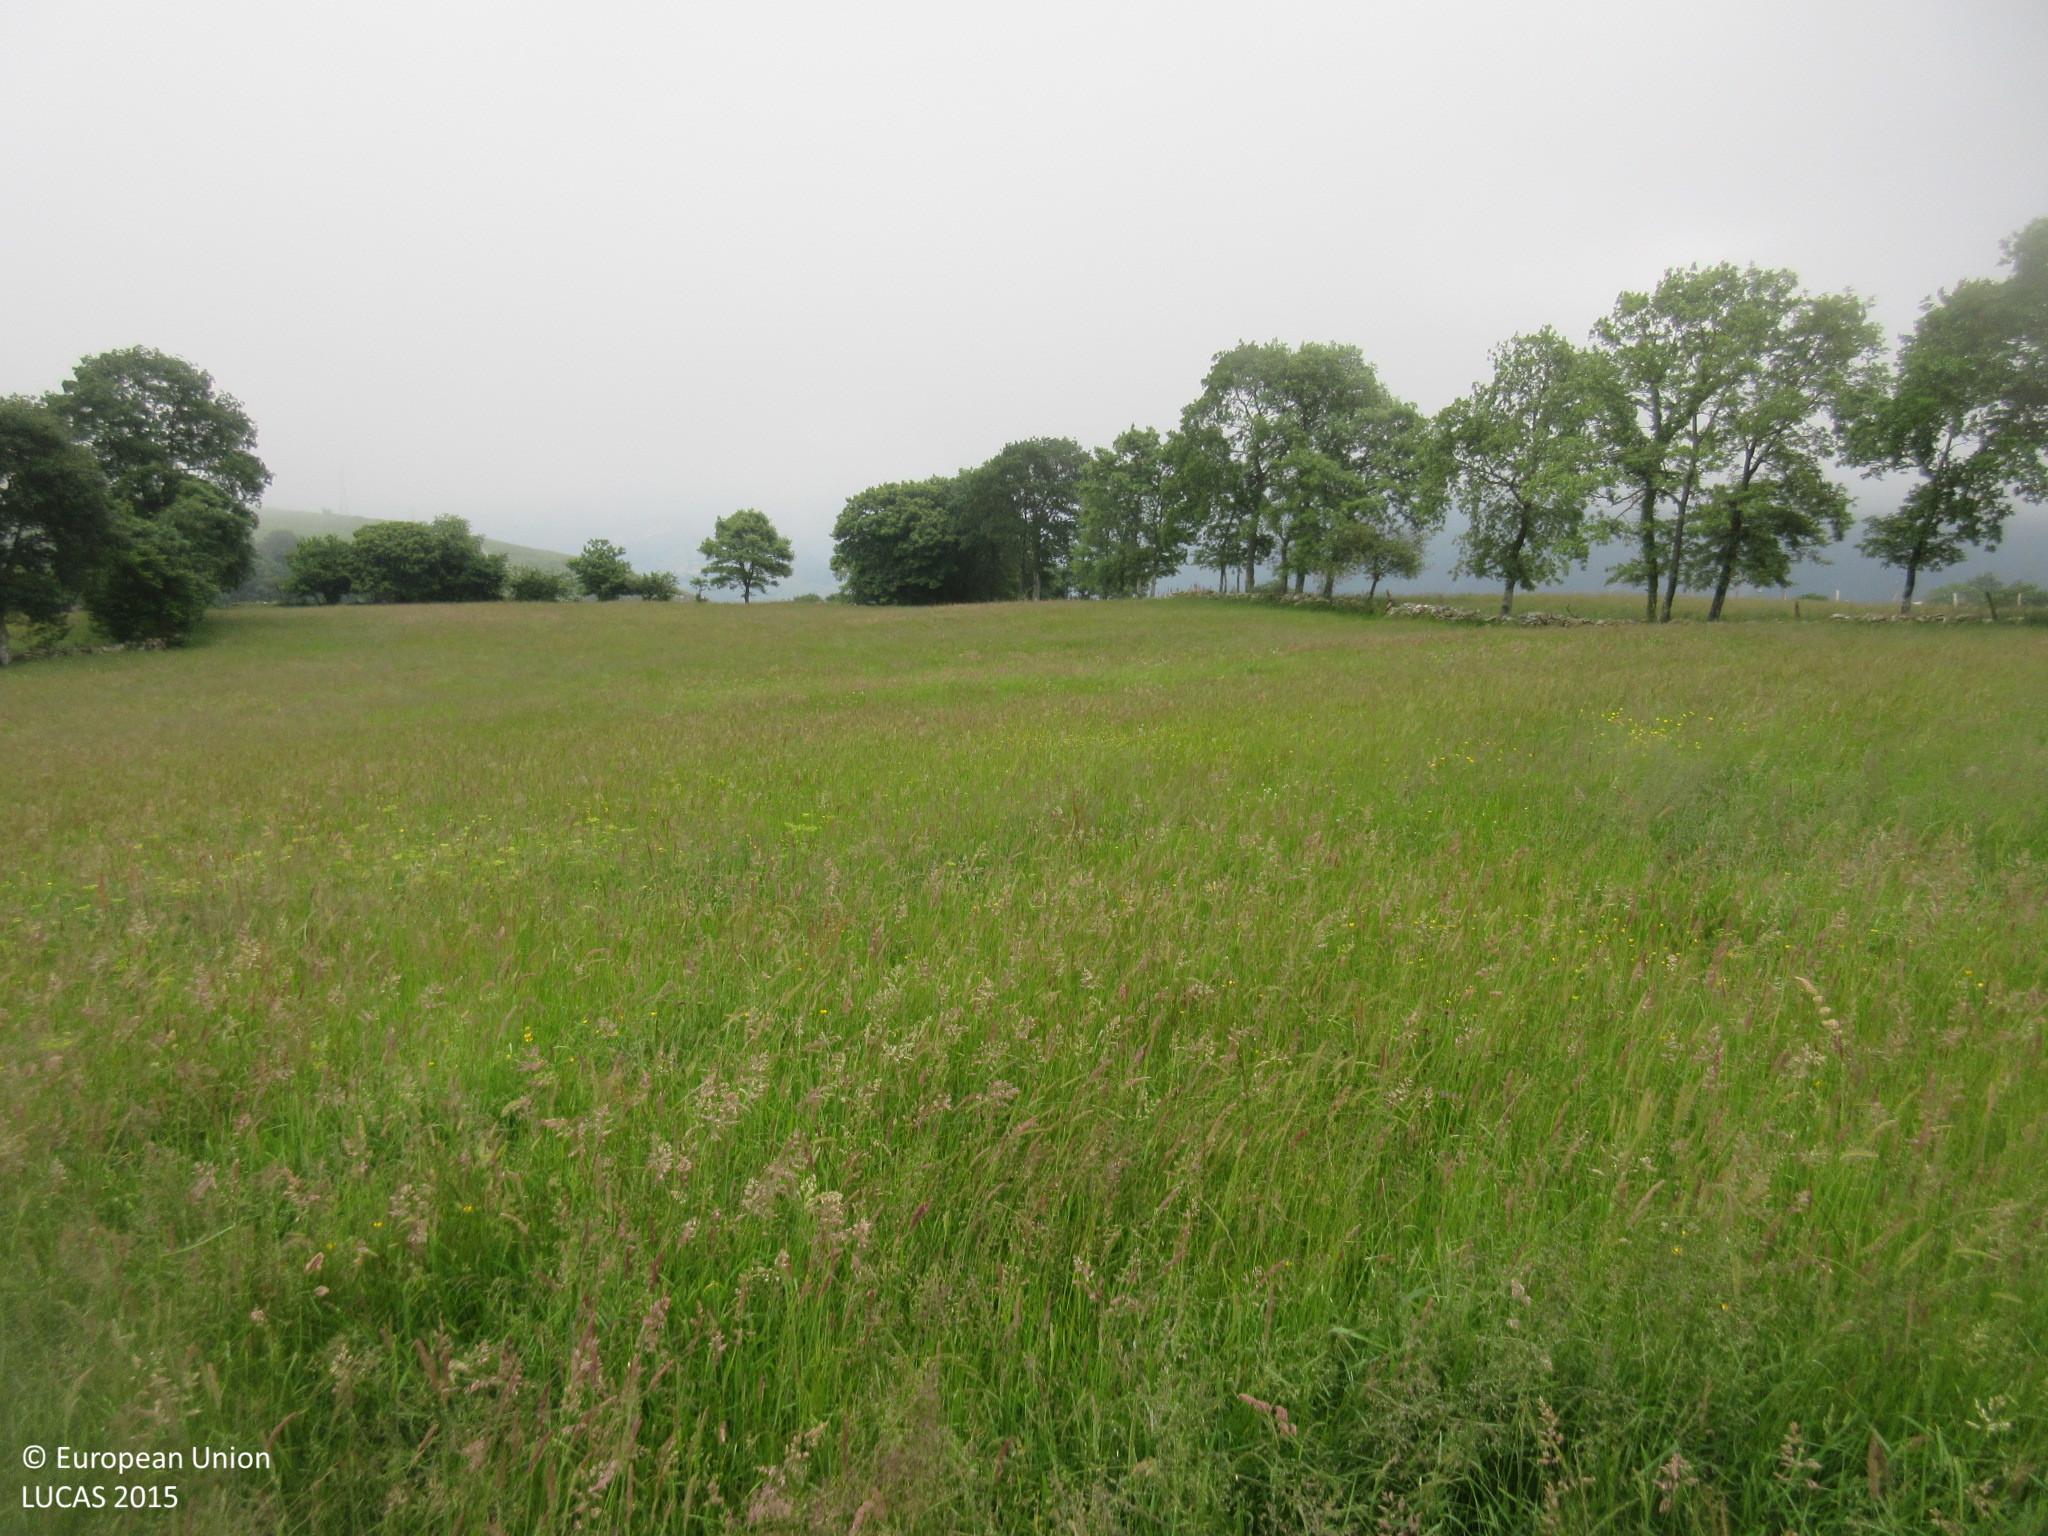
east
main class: Grassland
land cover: Grassland without tree/shrub cover
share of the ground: > 75 %
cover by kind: herbaceous plants 100 %
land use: Agriculture (excluding fallow land and kitchen gardens)
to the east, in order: Grassland without tree/shrub cover; Dry stone walls; Groves; Grassland without tree/shrub cover; Dry stone walls; Fences; Groves; Grassland without tree/shrub cover; Artificial constructions in urban areas
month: June
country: ES
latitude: 43.3635
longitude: -6.3002
